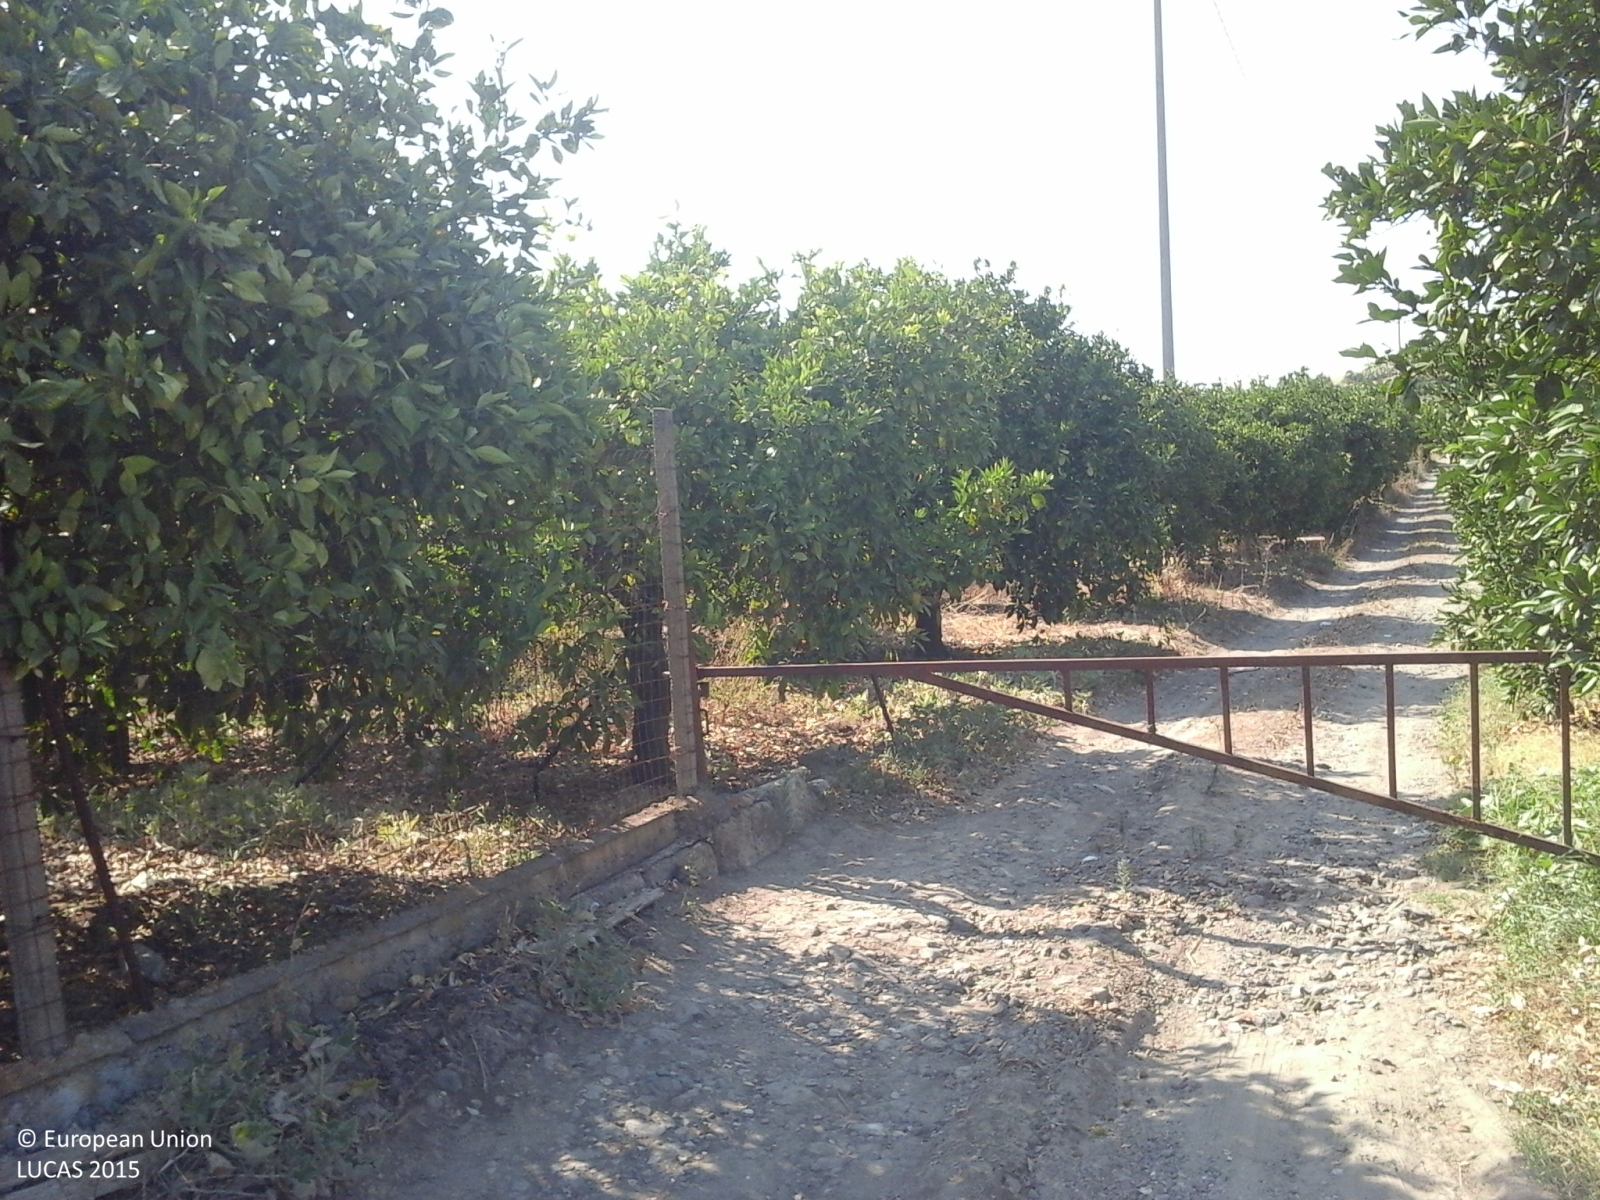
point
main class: Cropland
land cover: Oranges
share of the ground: > 75 %
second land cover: Spontaneously vegetated surfaces
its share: > 75 %
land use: Agriculture (excluding fallow land and kitchen gardens)
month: July
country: IT
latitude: 37.3713
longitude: 14.8087
